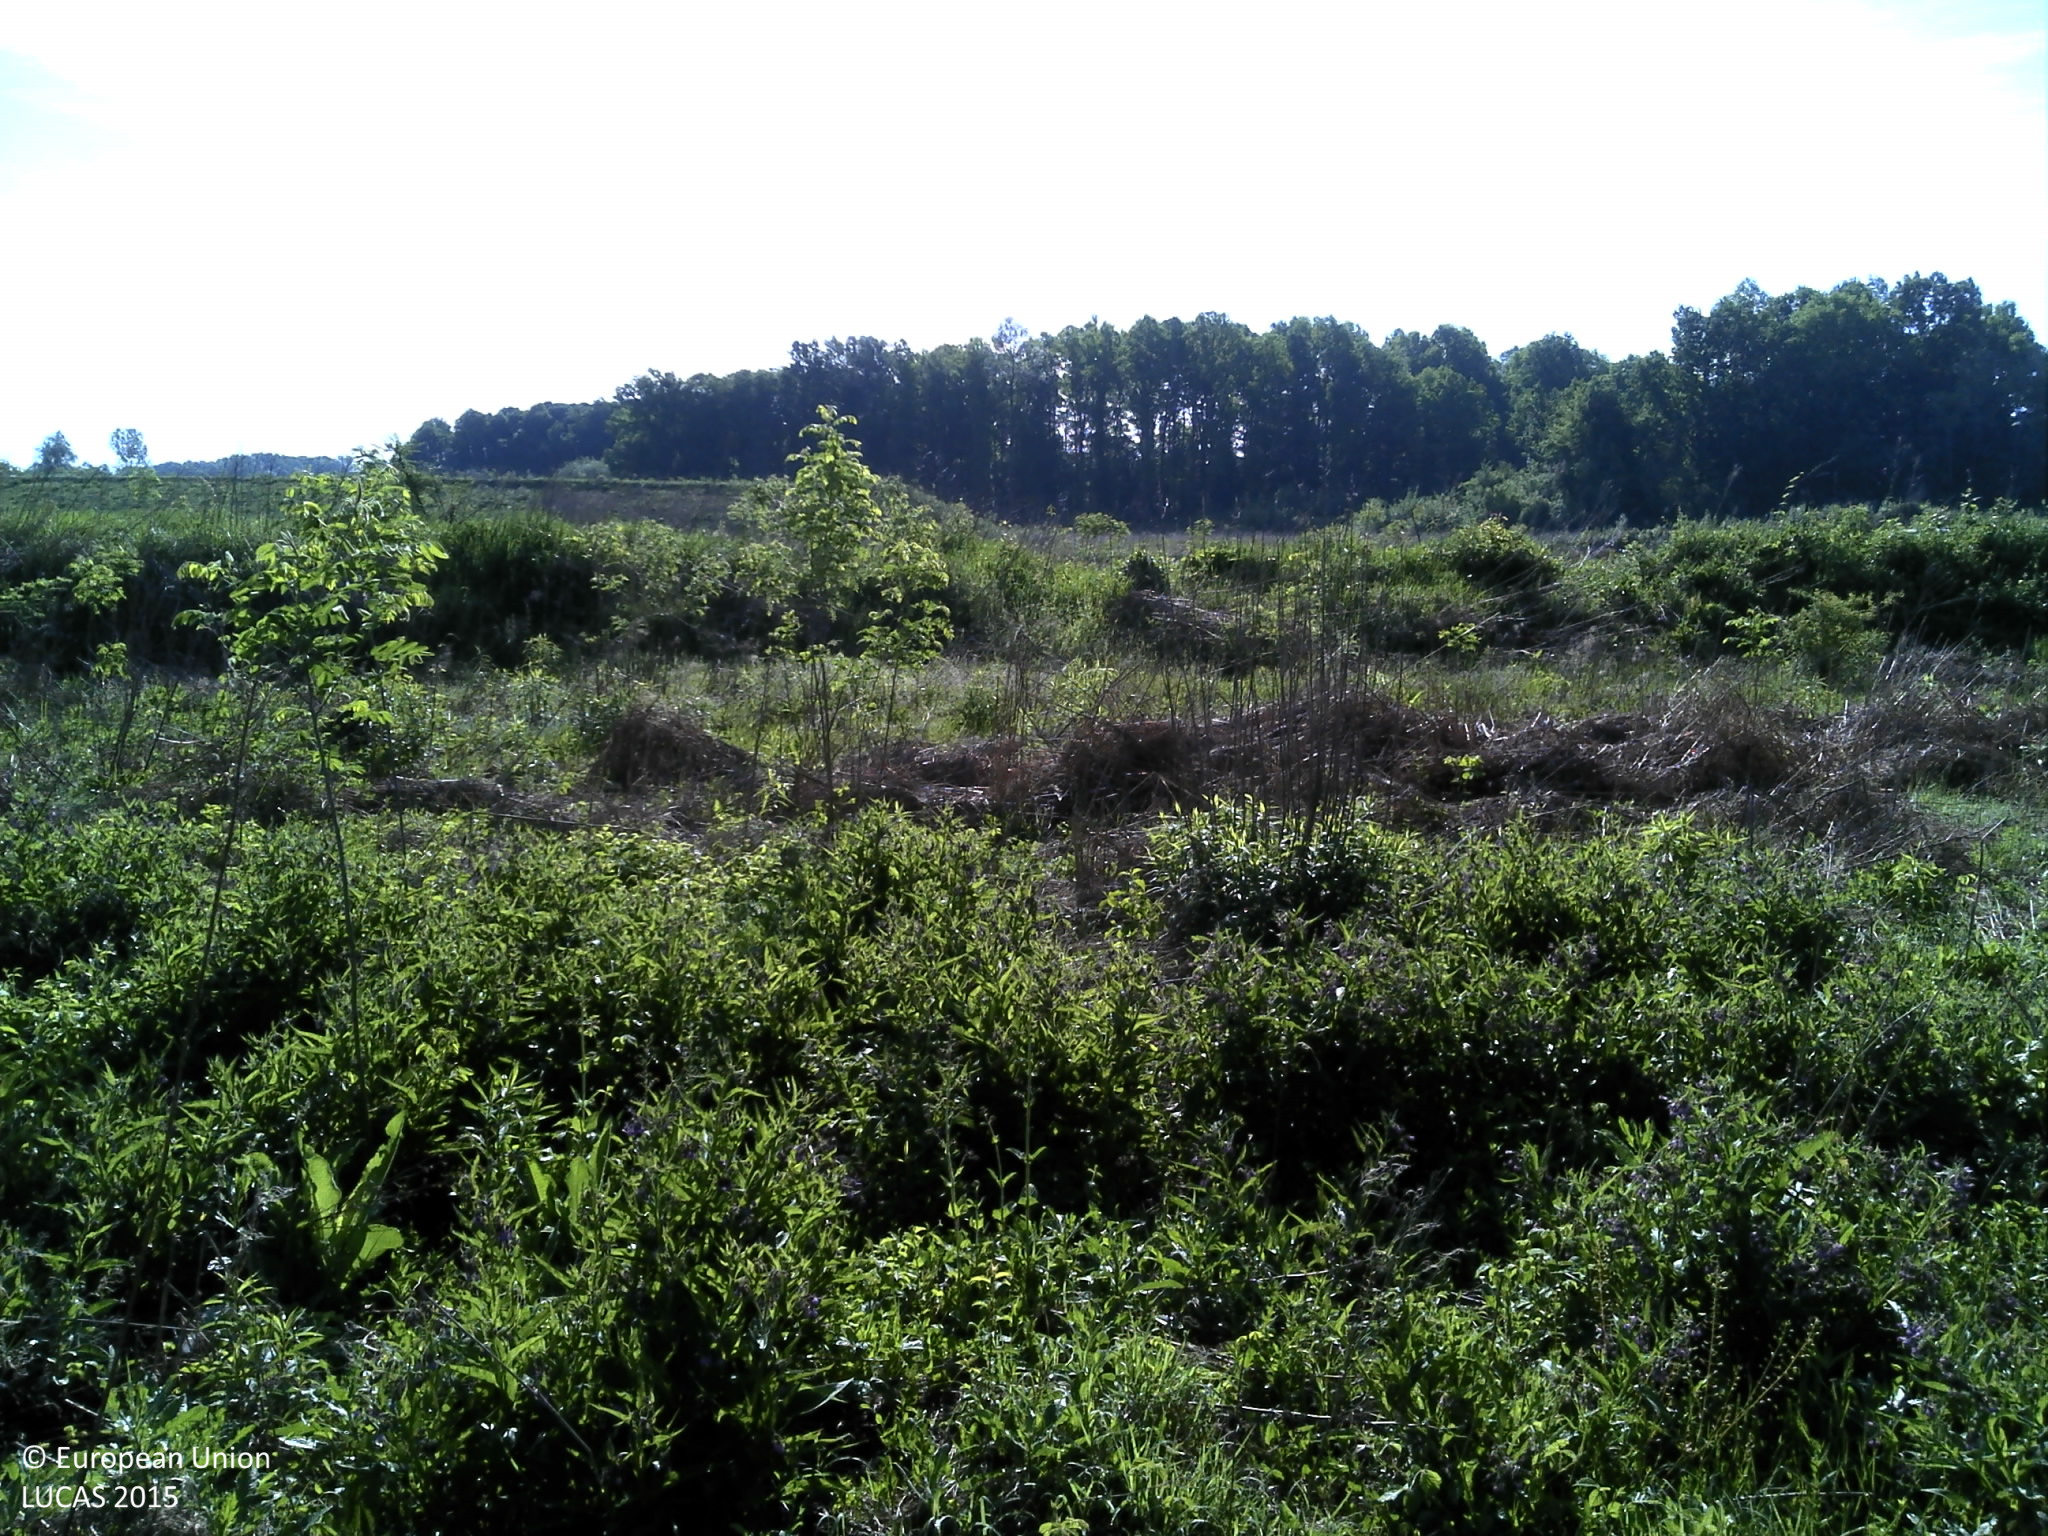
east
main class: Shrubland
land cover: Shrubland with sparse tree cover
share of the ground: > 75 %
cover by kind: shrubs 90 %, broadleaved forest trees 5 %, herbaceous plants 5 %
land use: Semi-natural and natural areas not in use
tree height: > 5 m
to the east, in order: Shrubland with sparse tree cover; Tracks; Inland fresh running water; Spontaneously vegetated surfaces
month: May
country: HR
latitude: 45.1302
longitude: 18.4342
